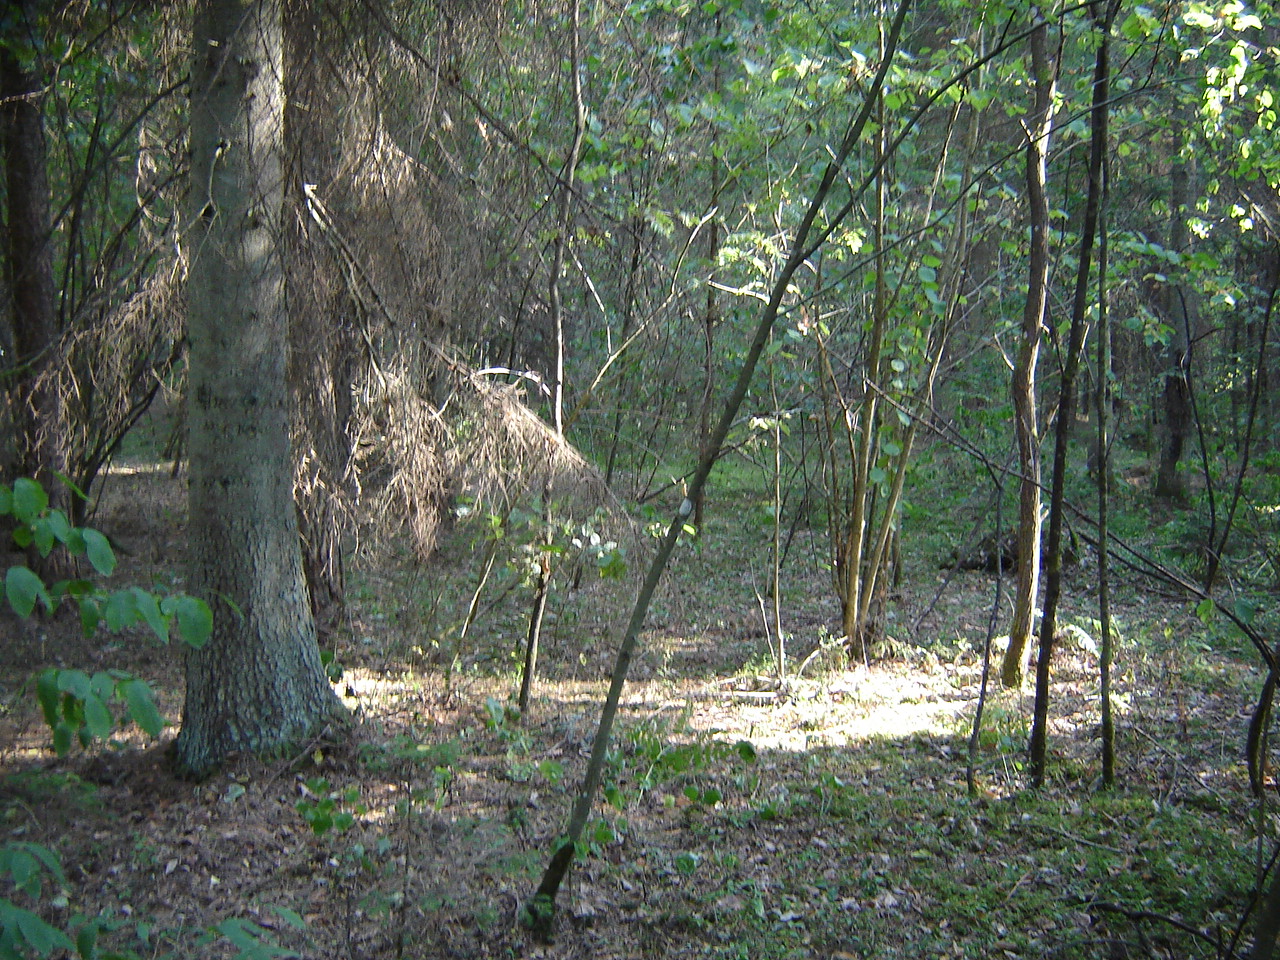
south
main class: Woodland
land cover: Pine dominated mixed woodland
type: hemiboreal forest and nemoral coniferous forest and mixed broadleaved-coniferous forest
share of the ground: > 75 %
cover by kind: coniferous forest trees 65 %, broadleaved forest trees 30 %, unconsolidated bare surface 5 %
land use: Forestry
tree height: > 5 m
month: August
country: LT
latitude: 54.5242
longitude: 24.7401
